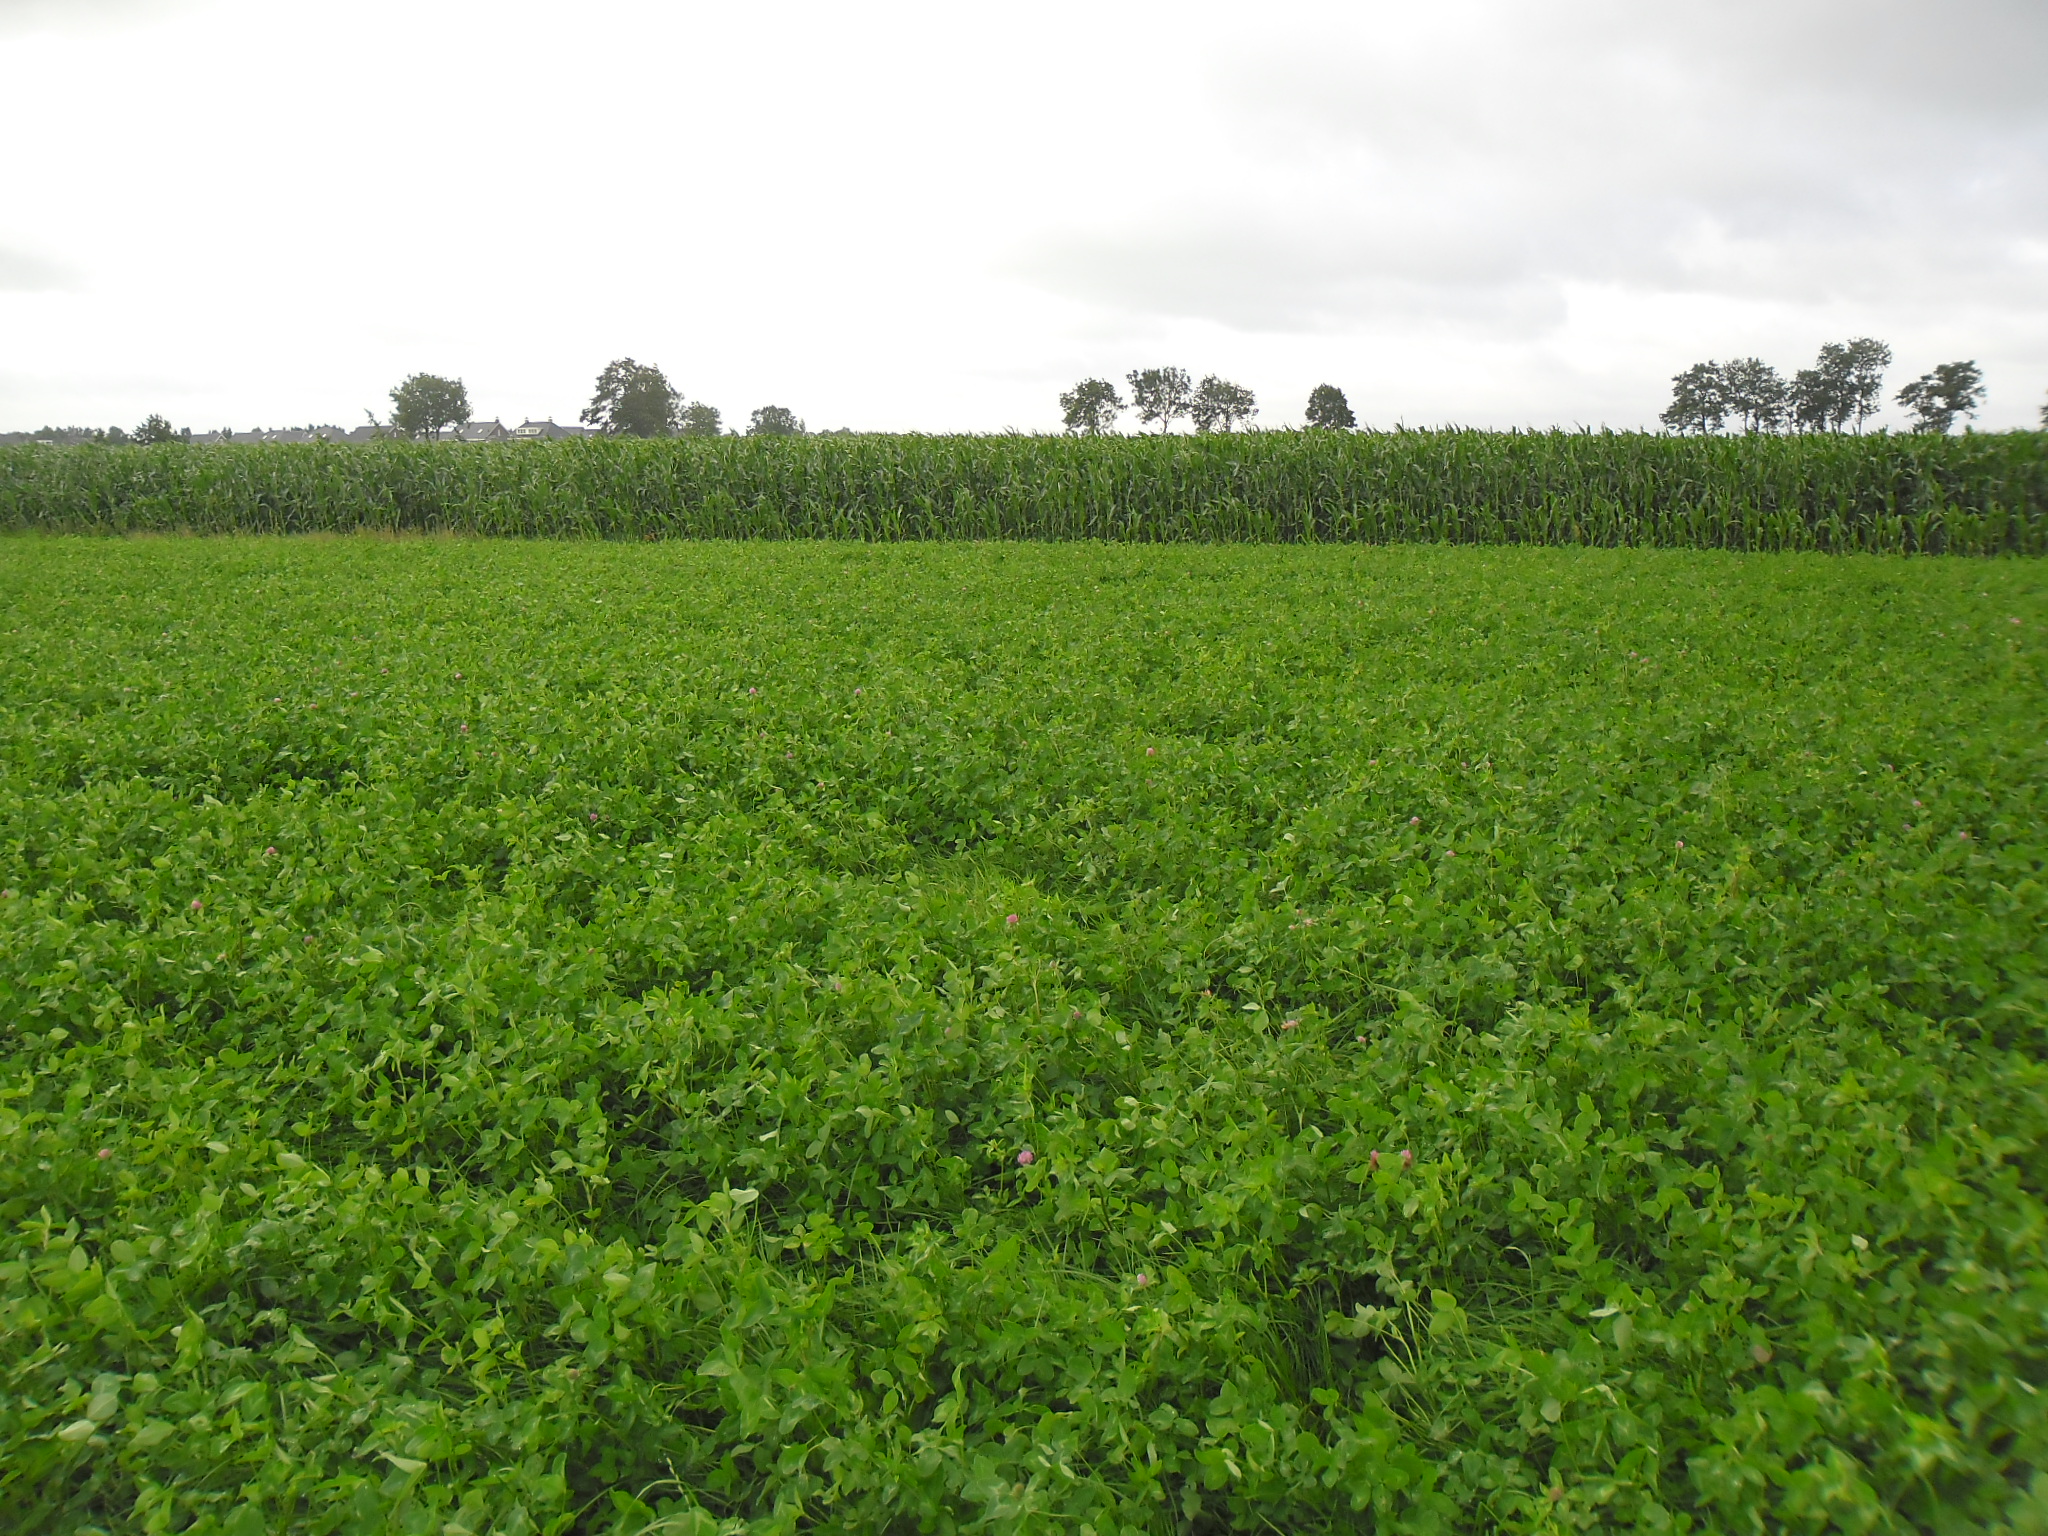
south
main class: Cropland
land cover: Other leguminous and mixtures for fodder
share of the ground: > 75 %
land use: Agriculture (excluding fallow land and kitchen gardens)
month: July
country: NL
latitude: 52.6218
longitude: 6.1736
